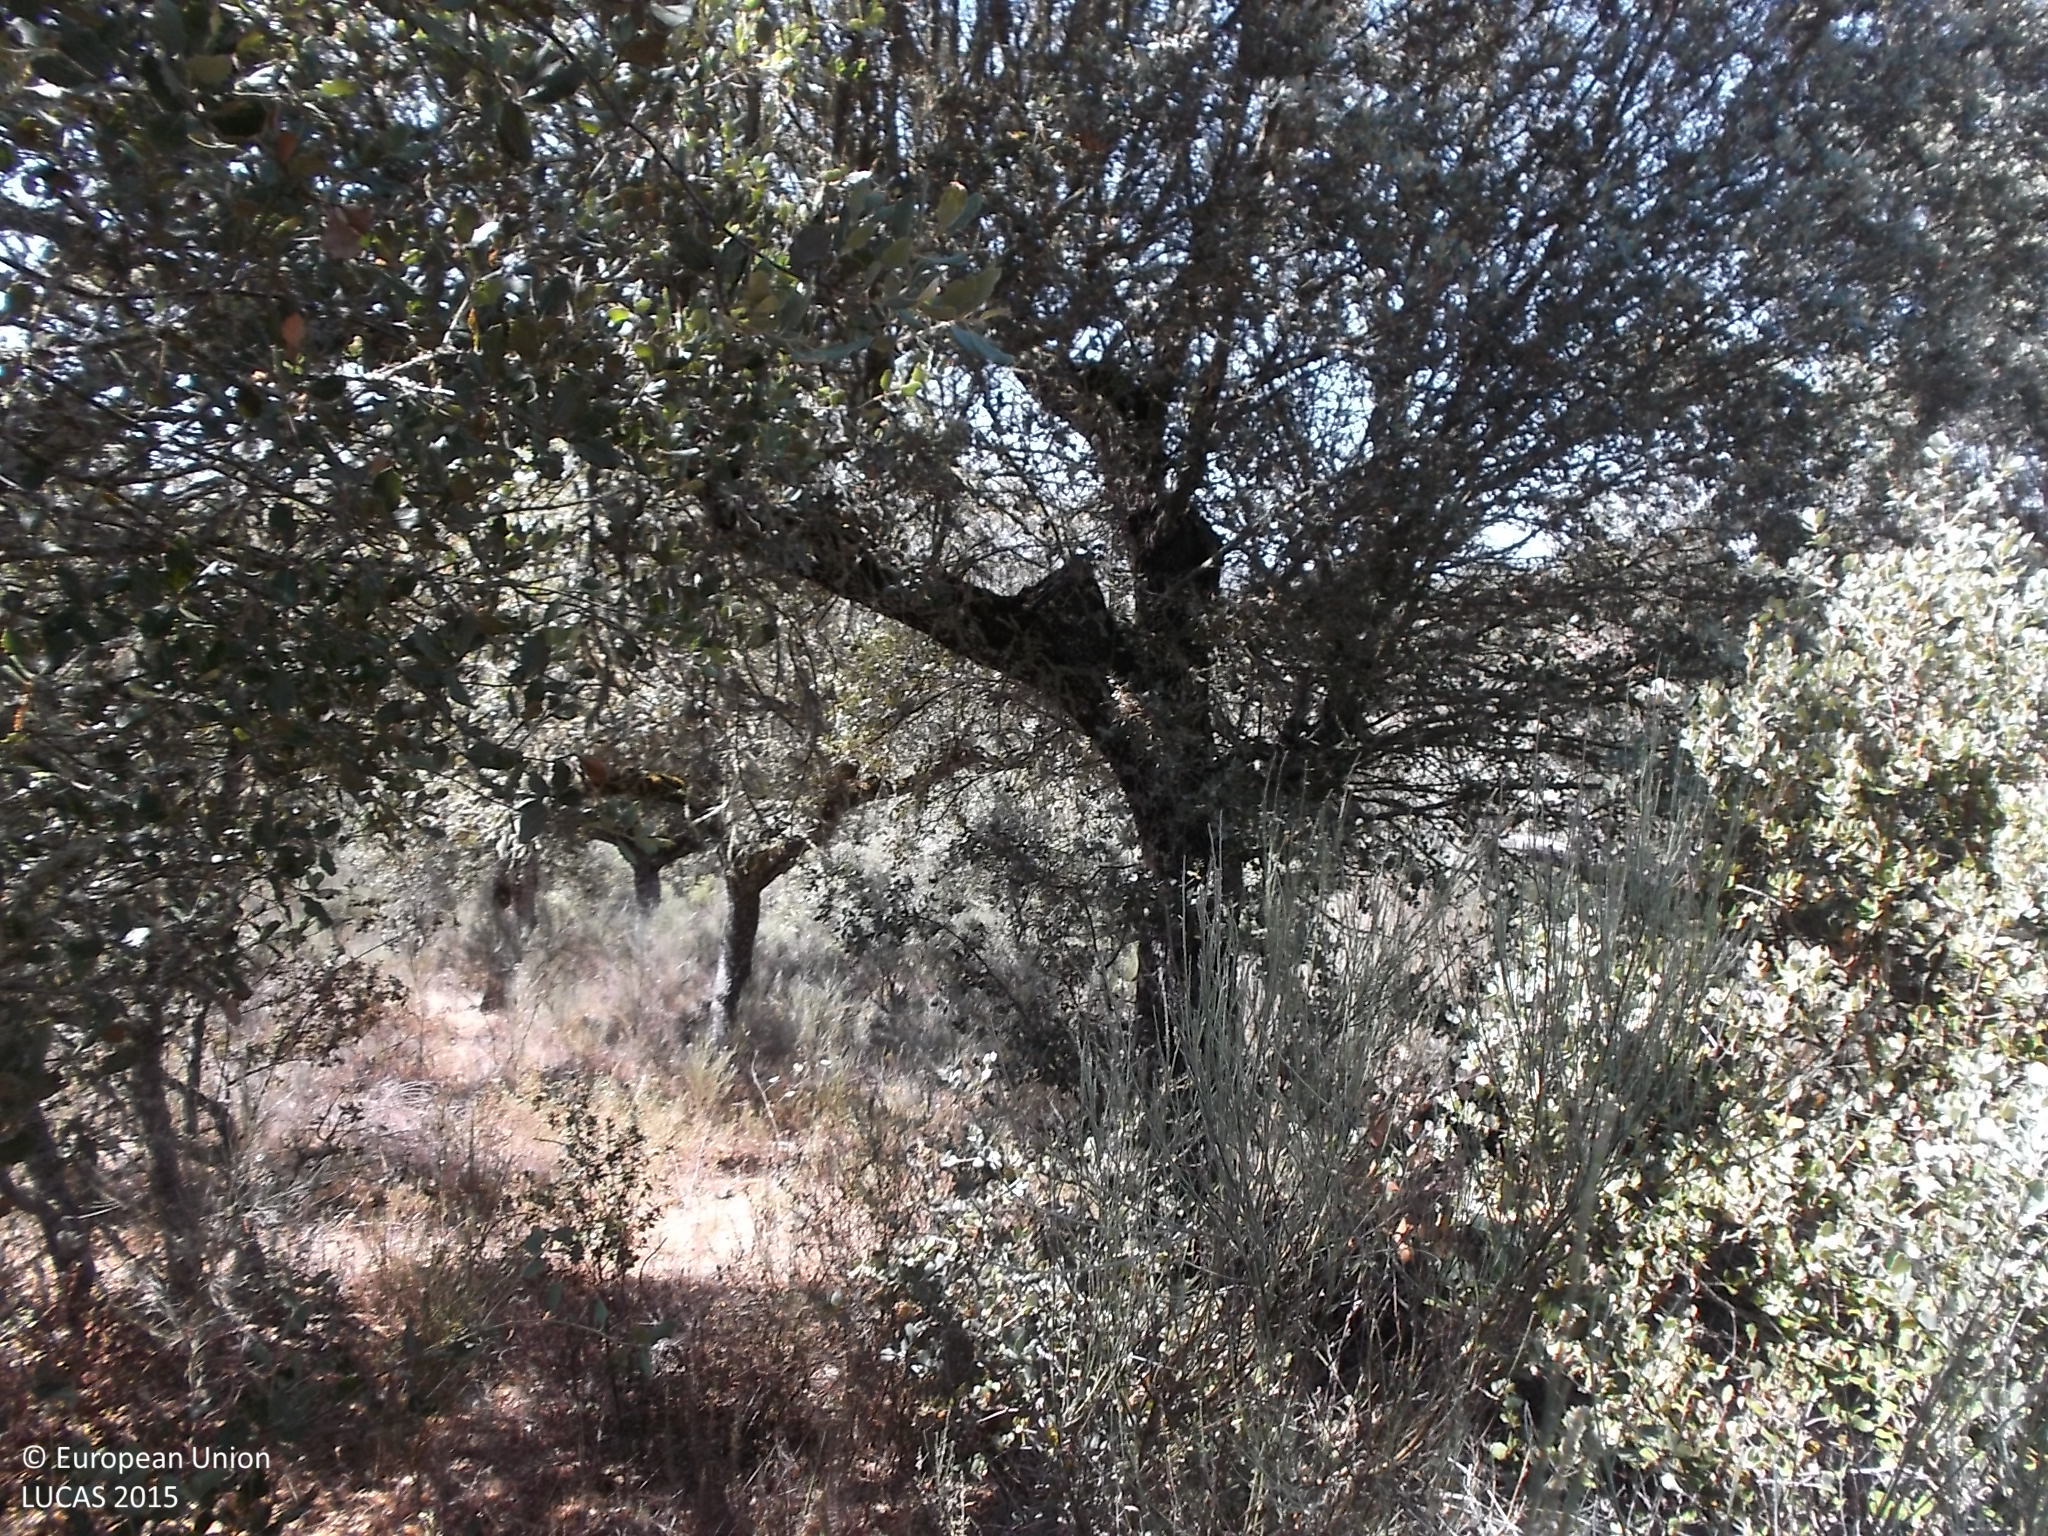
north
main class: Woodland
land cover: Broadleaved woodland
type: broadleaved evergreen forest
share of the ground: 50 - 75 %
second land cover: Shrubland without tree cover
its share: 50 - 75 %
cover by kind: broadleaved forest trees 60 %, shrubs 40 %
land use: Forestry
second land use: Agriculture (excluding fallow land and kitchen gardens)
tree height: < 5 m
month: July
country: ES
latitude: 40.7269
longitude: -6.7796
